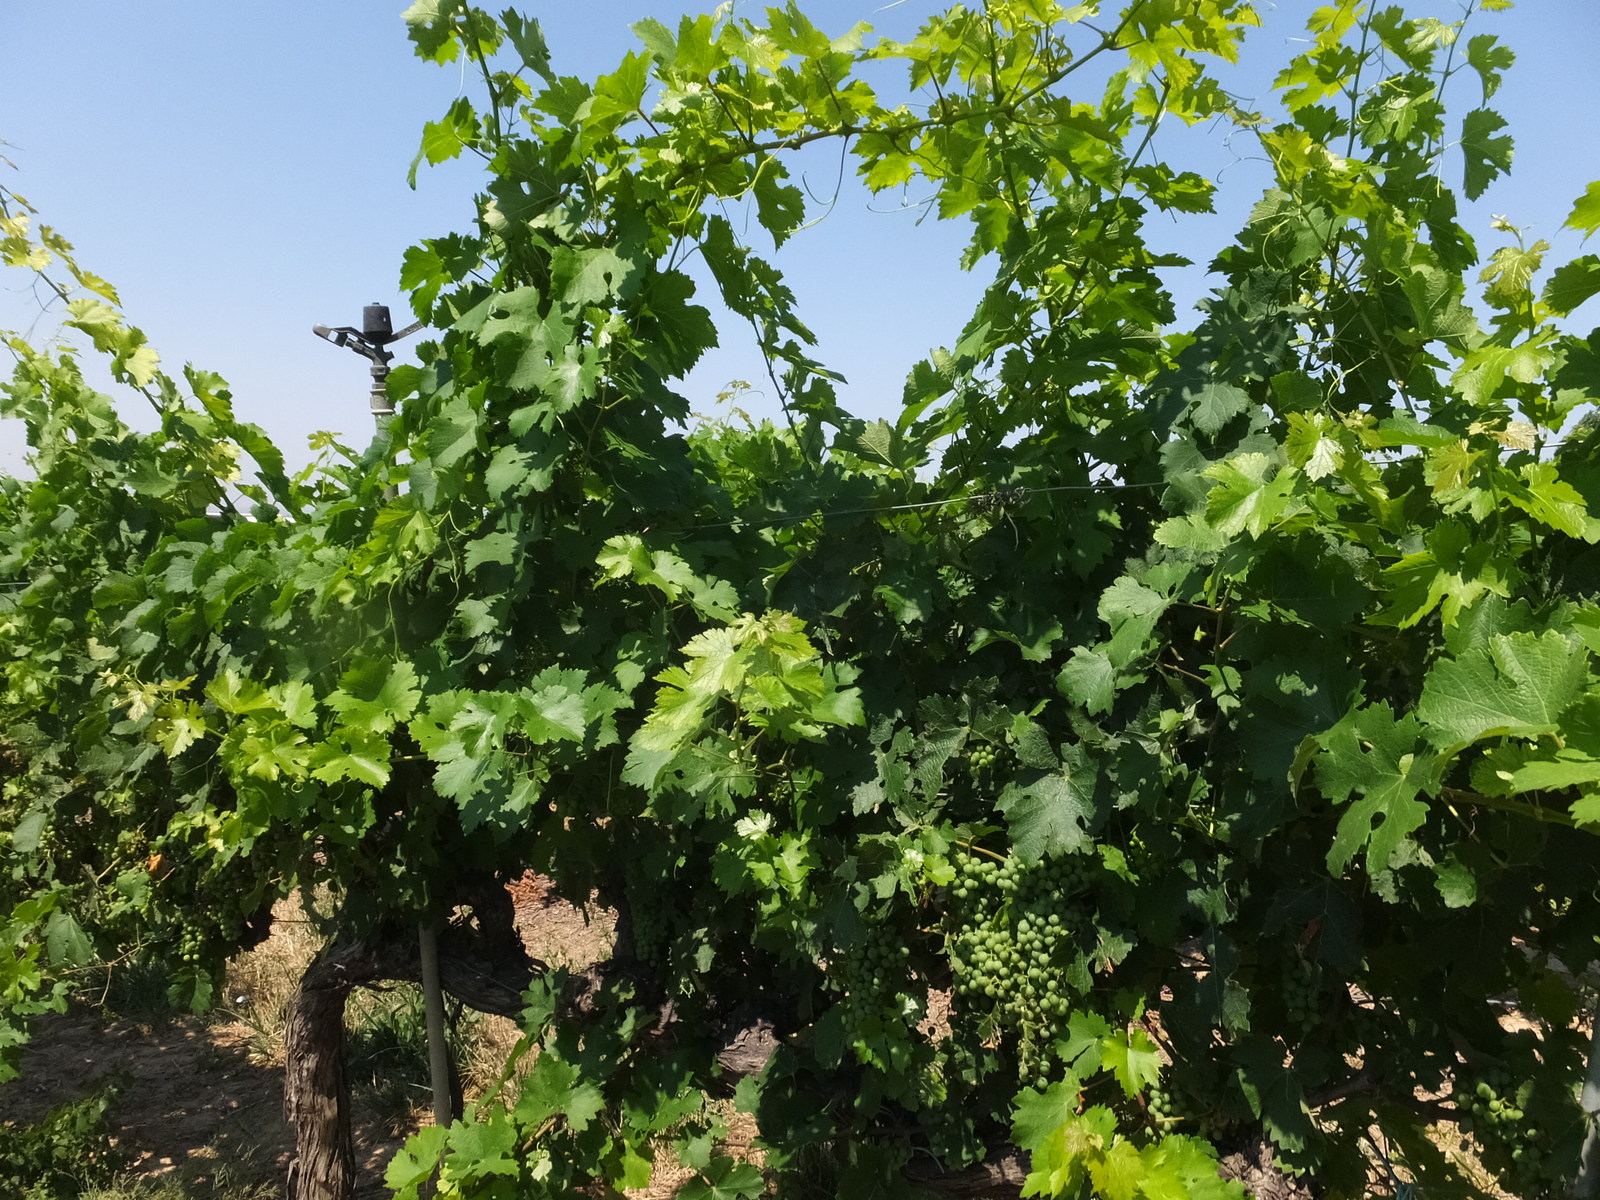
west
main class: Cropland
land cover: Vineyards
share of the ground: > 75 %
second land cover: Spontaneously vegetated surfaces
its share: 25 - 50 %
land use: Agriculture (excluding fallow land and kitchen gardens)
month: June
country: ES
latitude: 41.7451
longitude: 0.4259
